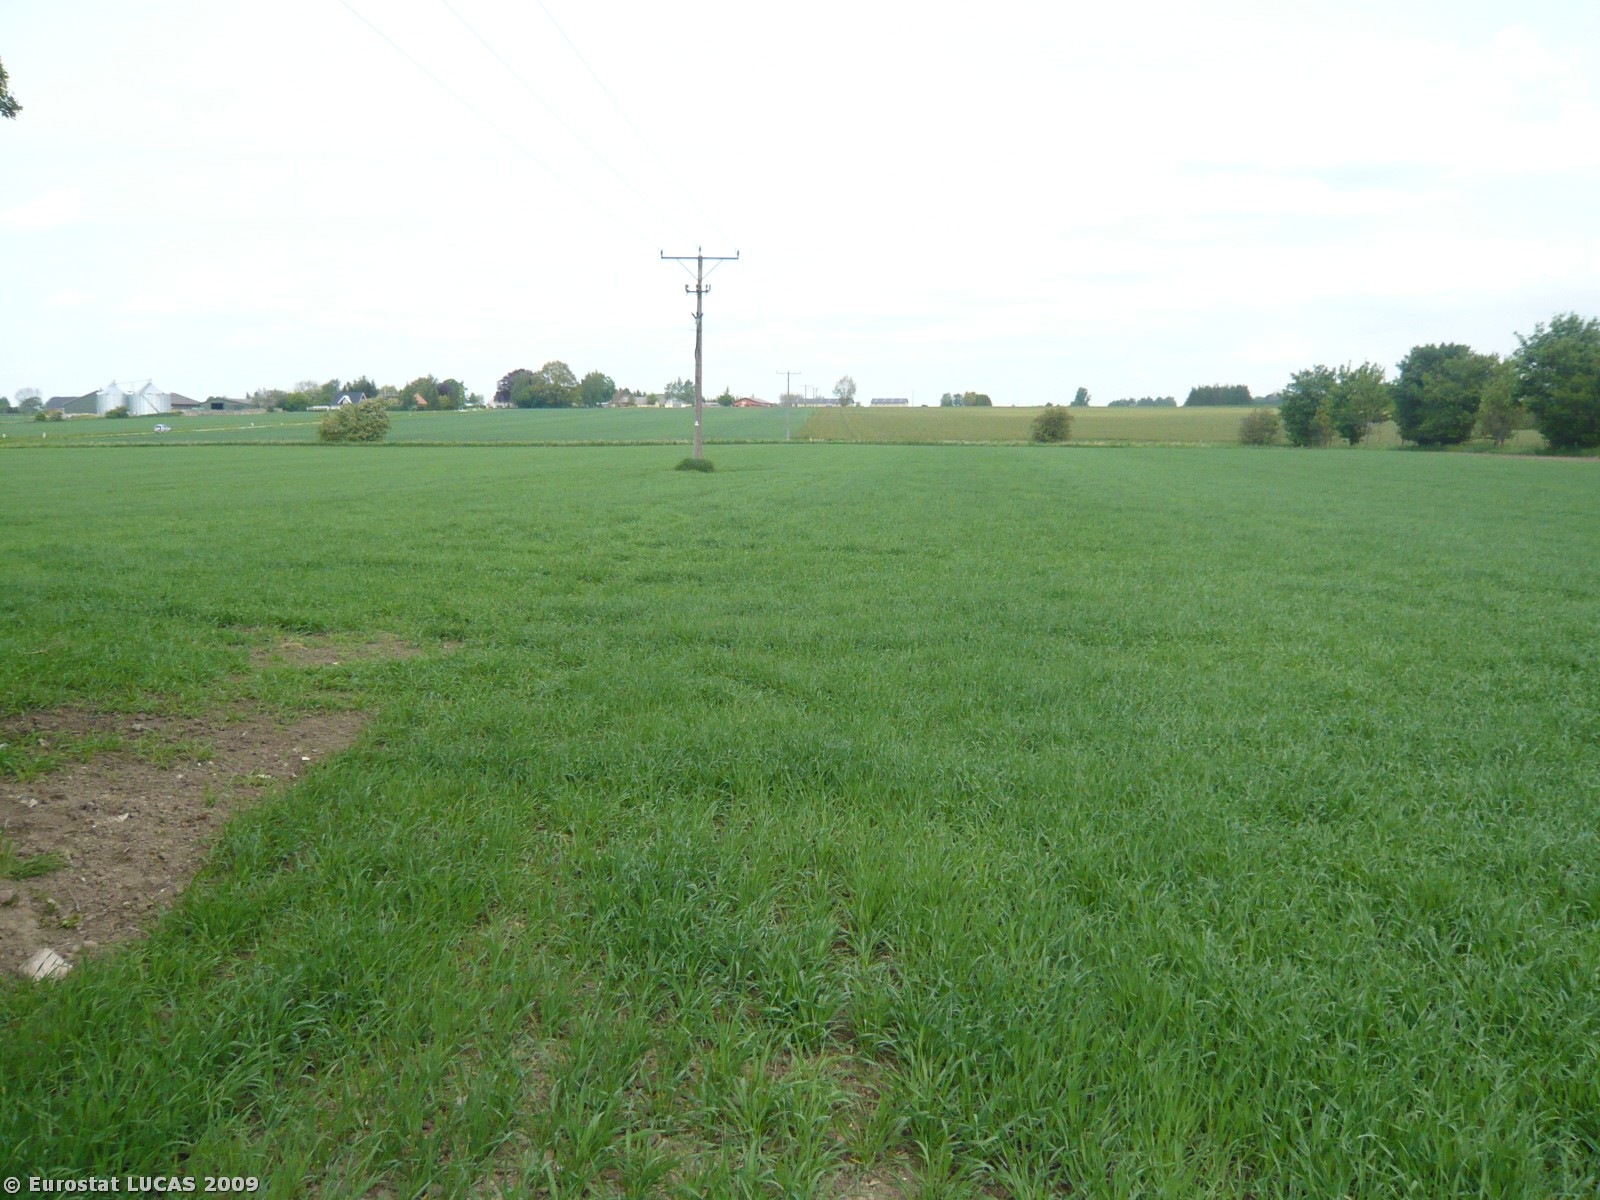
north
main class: Cropland
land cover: Barley
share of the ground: > 75 %
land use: Agriculture (excluding fallow land and kitchen gardens)
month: May
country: DK
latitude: 55.3465
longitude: 11.9066
